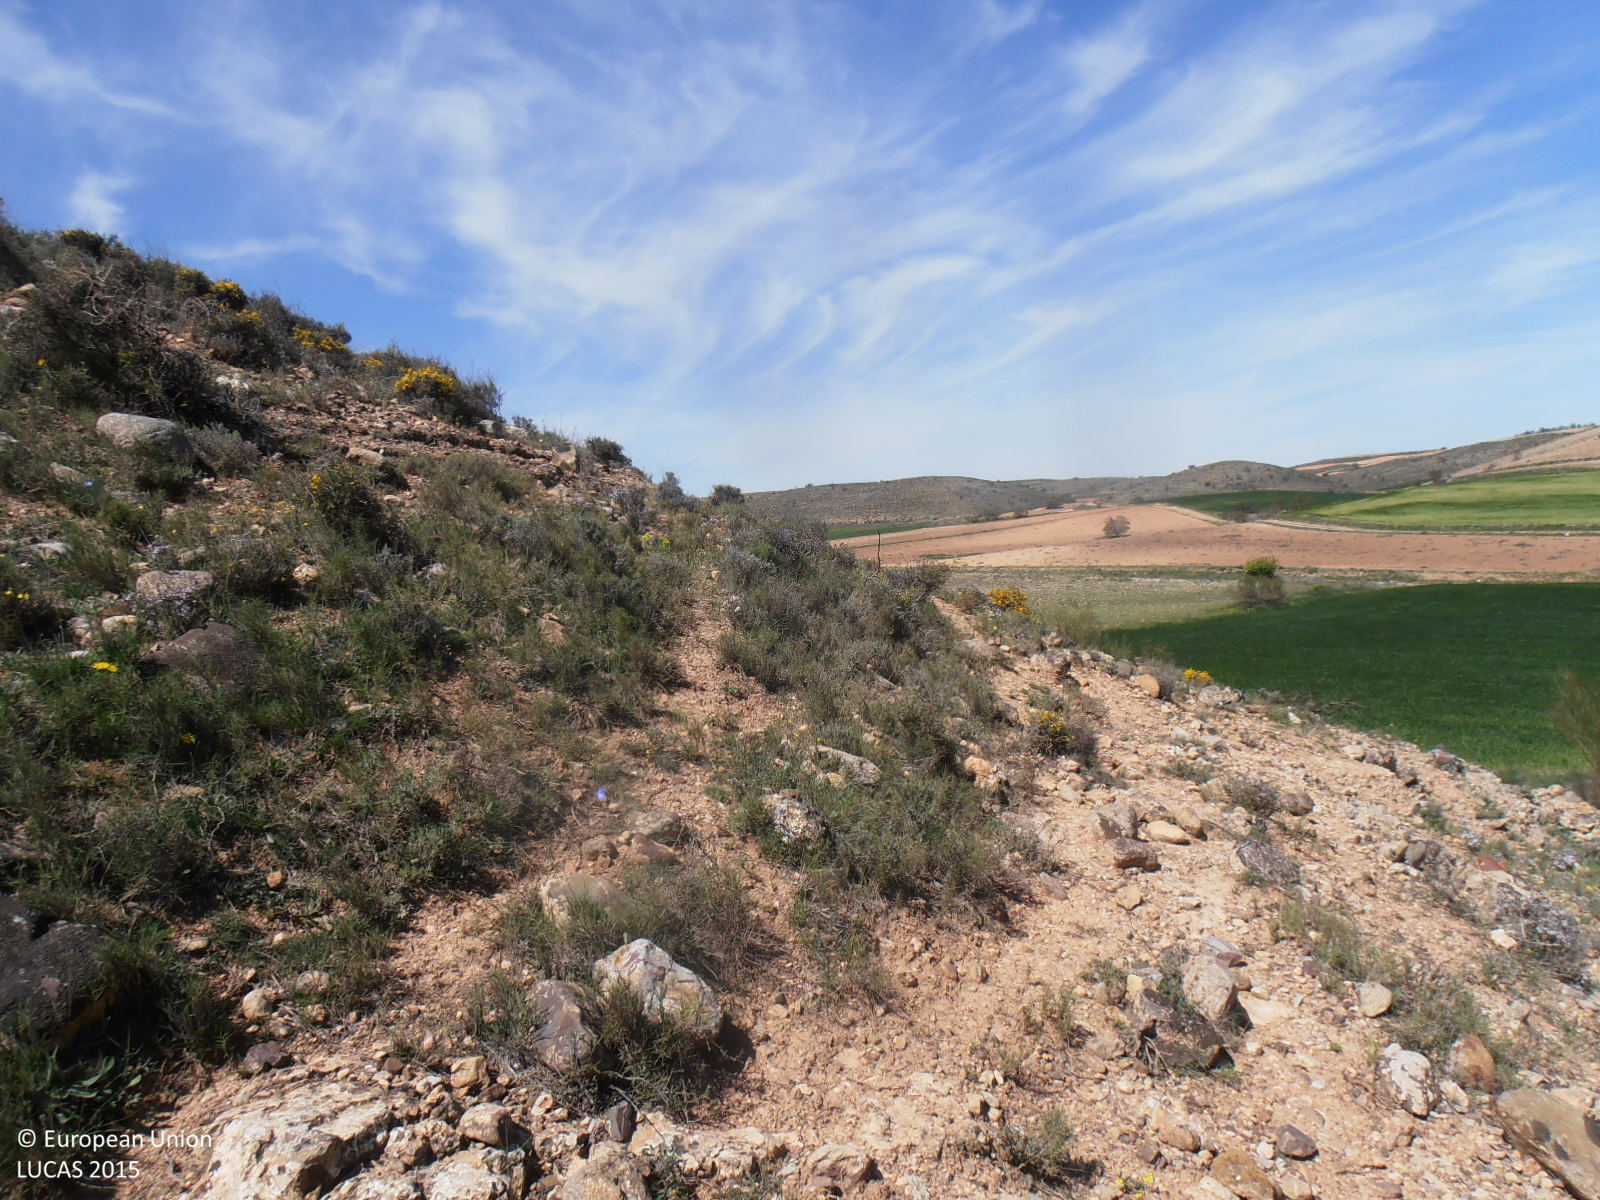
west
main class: Shrubland
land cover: Shrubland without tree cover
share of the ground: 50 - 75 %
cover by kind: shrubs 60 %, consolidated bare surface 25 %, herbaceous plants 15 %
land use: Semi-natural and natural areas not in use
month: April
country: ES
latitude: 41.2251
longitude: -0.9093
